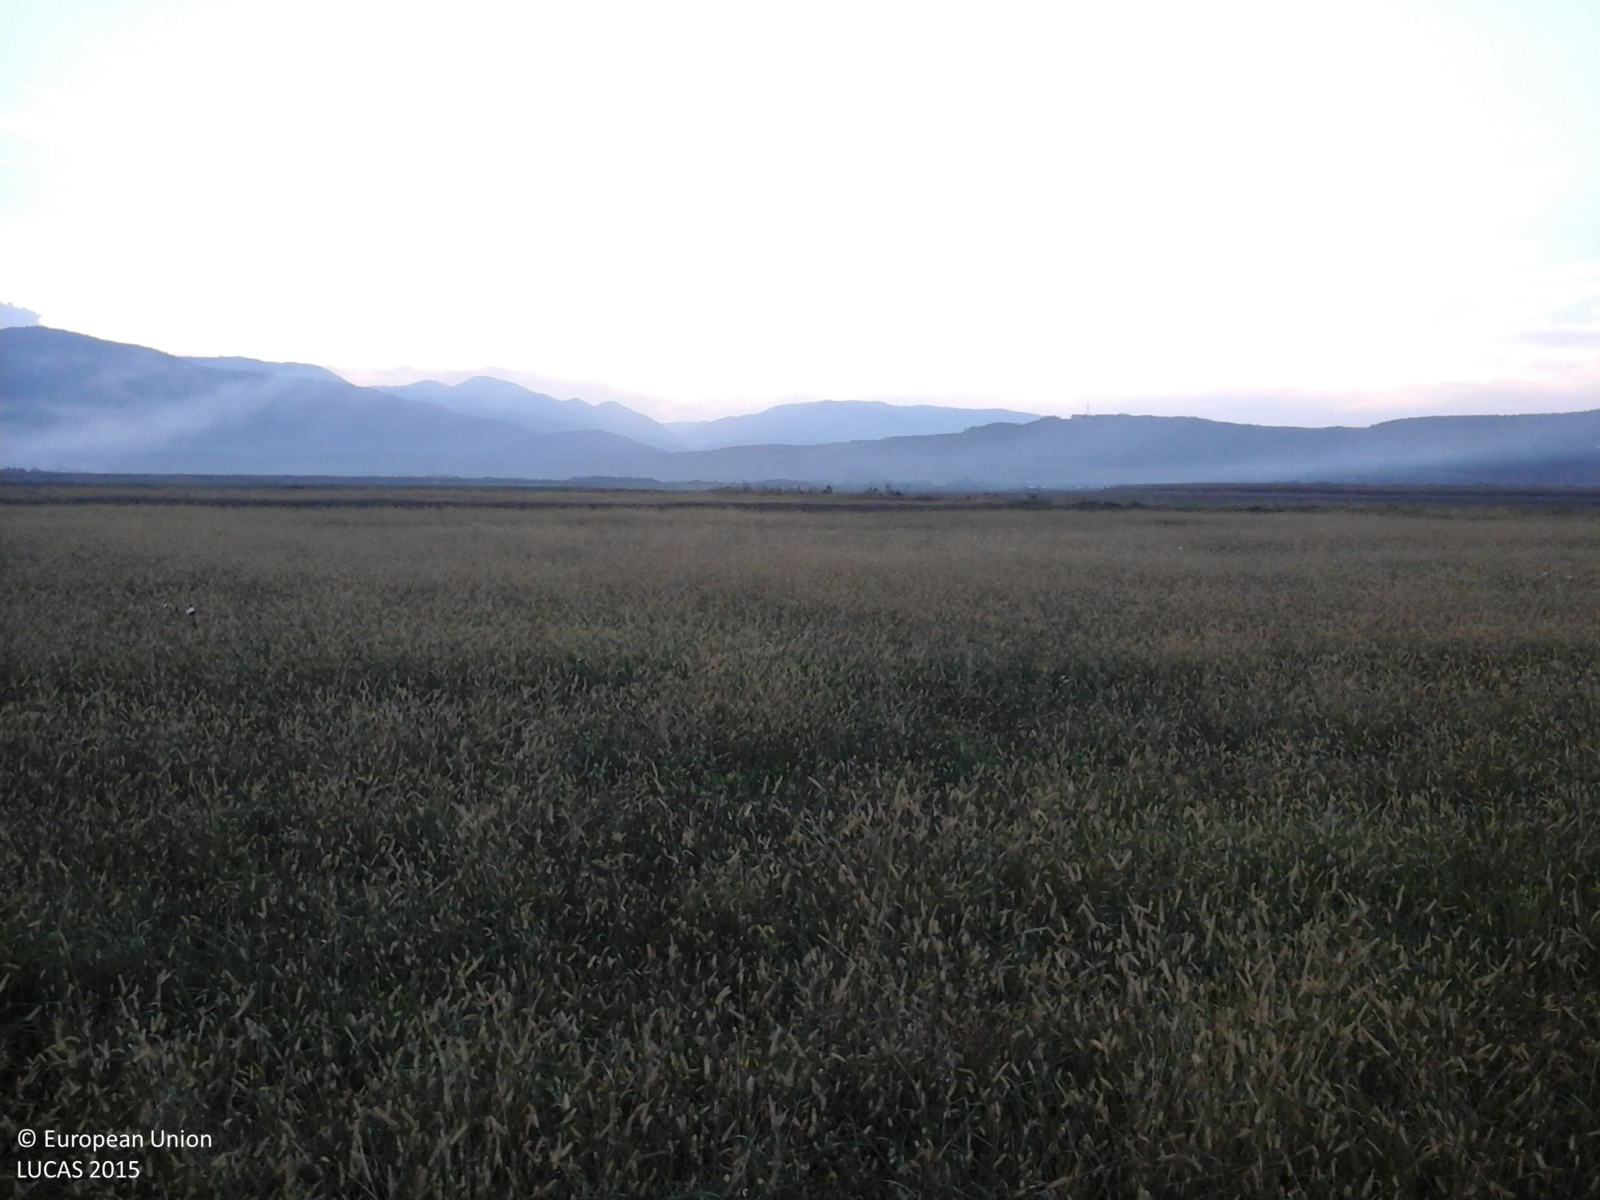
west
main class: Grassland
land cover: Grassland without tree/shrub cover
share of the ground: > 75 %
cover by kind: herbaceous plants 100 %
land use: Agriculture (excluding fallow land and kitchen gardens)
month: October
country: RO
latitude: 45.7722
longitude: 23.9990
